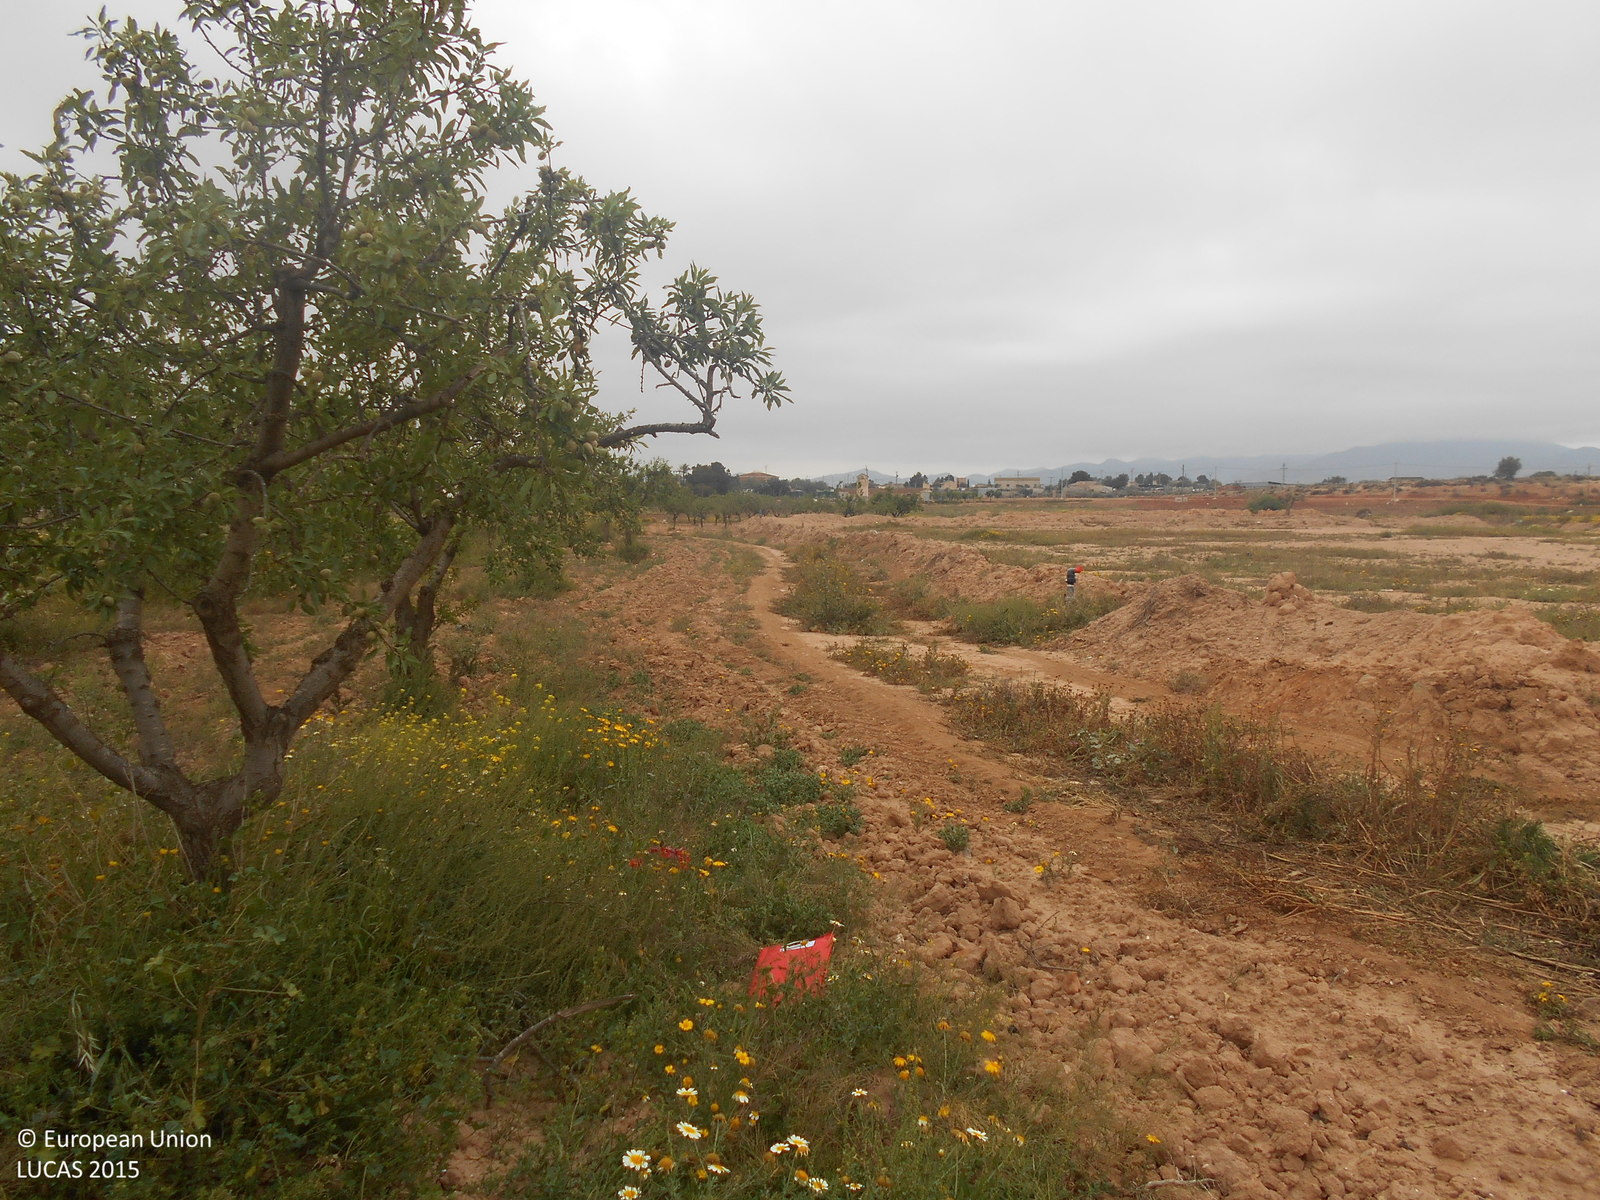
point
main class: Cropland
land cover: Nuts trees
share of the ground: 10 - 25 %
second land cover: Spontaneously vegetated surfaces
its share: 25 - 50 %
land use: Agriculture (excluding fallow land and kitchen gardens)
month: April
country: ES
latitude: 37.7364
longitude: -1.2492
